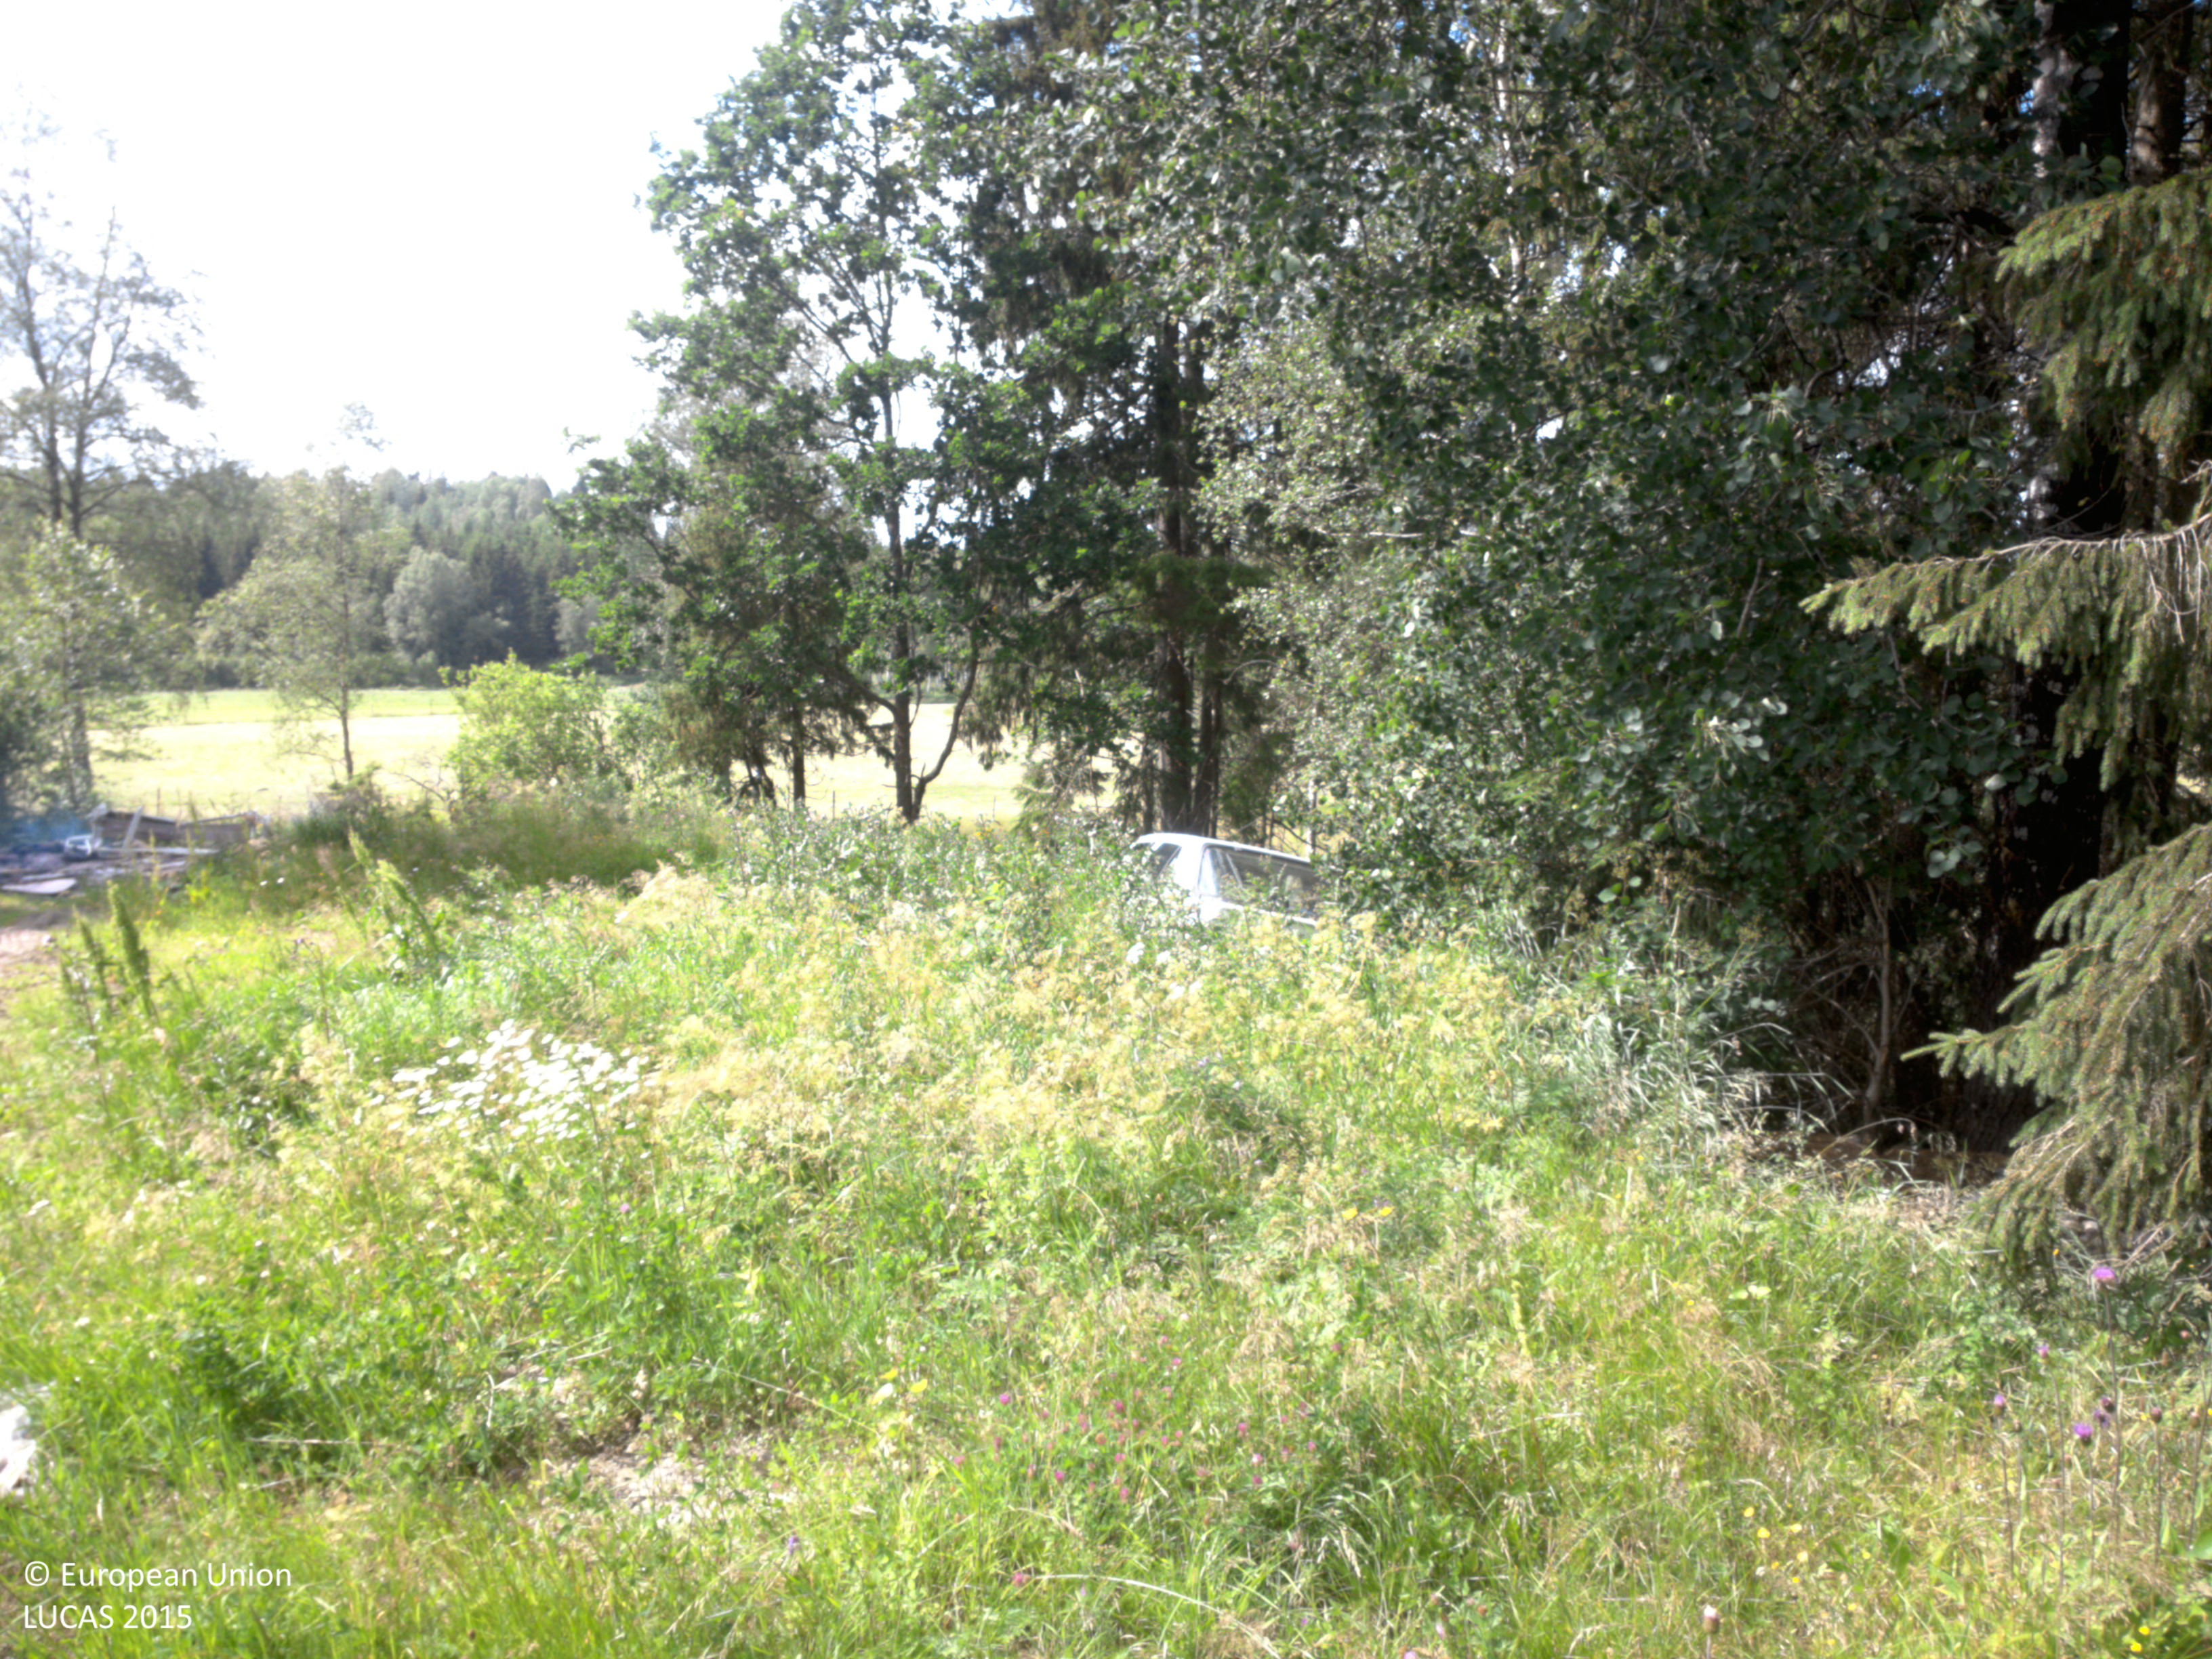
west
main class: Grassland
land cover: Grassland without tree/shrub cover
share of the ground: 50 - 75 %
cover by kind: herbaceous plants 65 %, unconsolidated bare surface 20 %, consolidated bare surface 15 %
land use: Residential
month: July
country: SE
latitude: 58.7801
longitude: 12.0193
